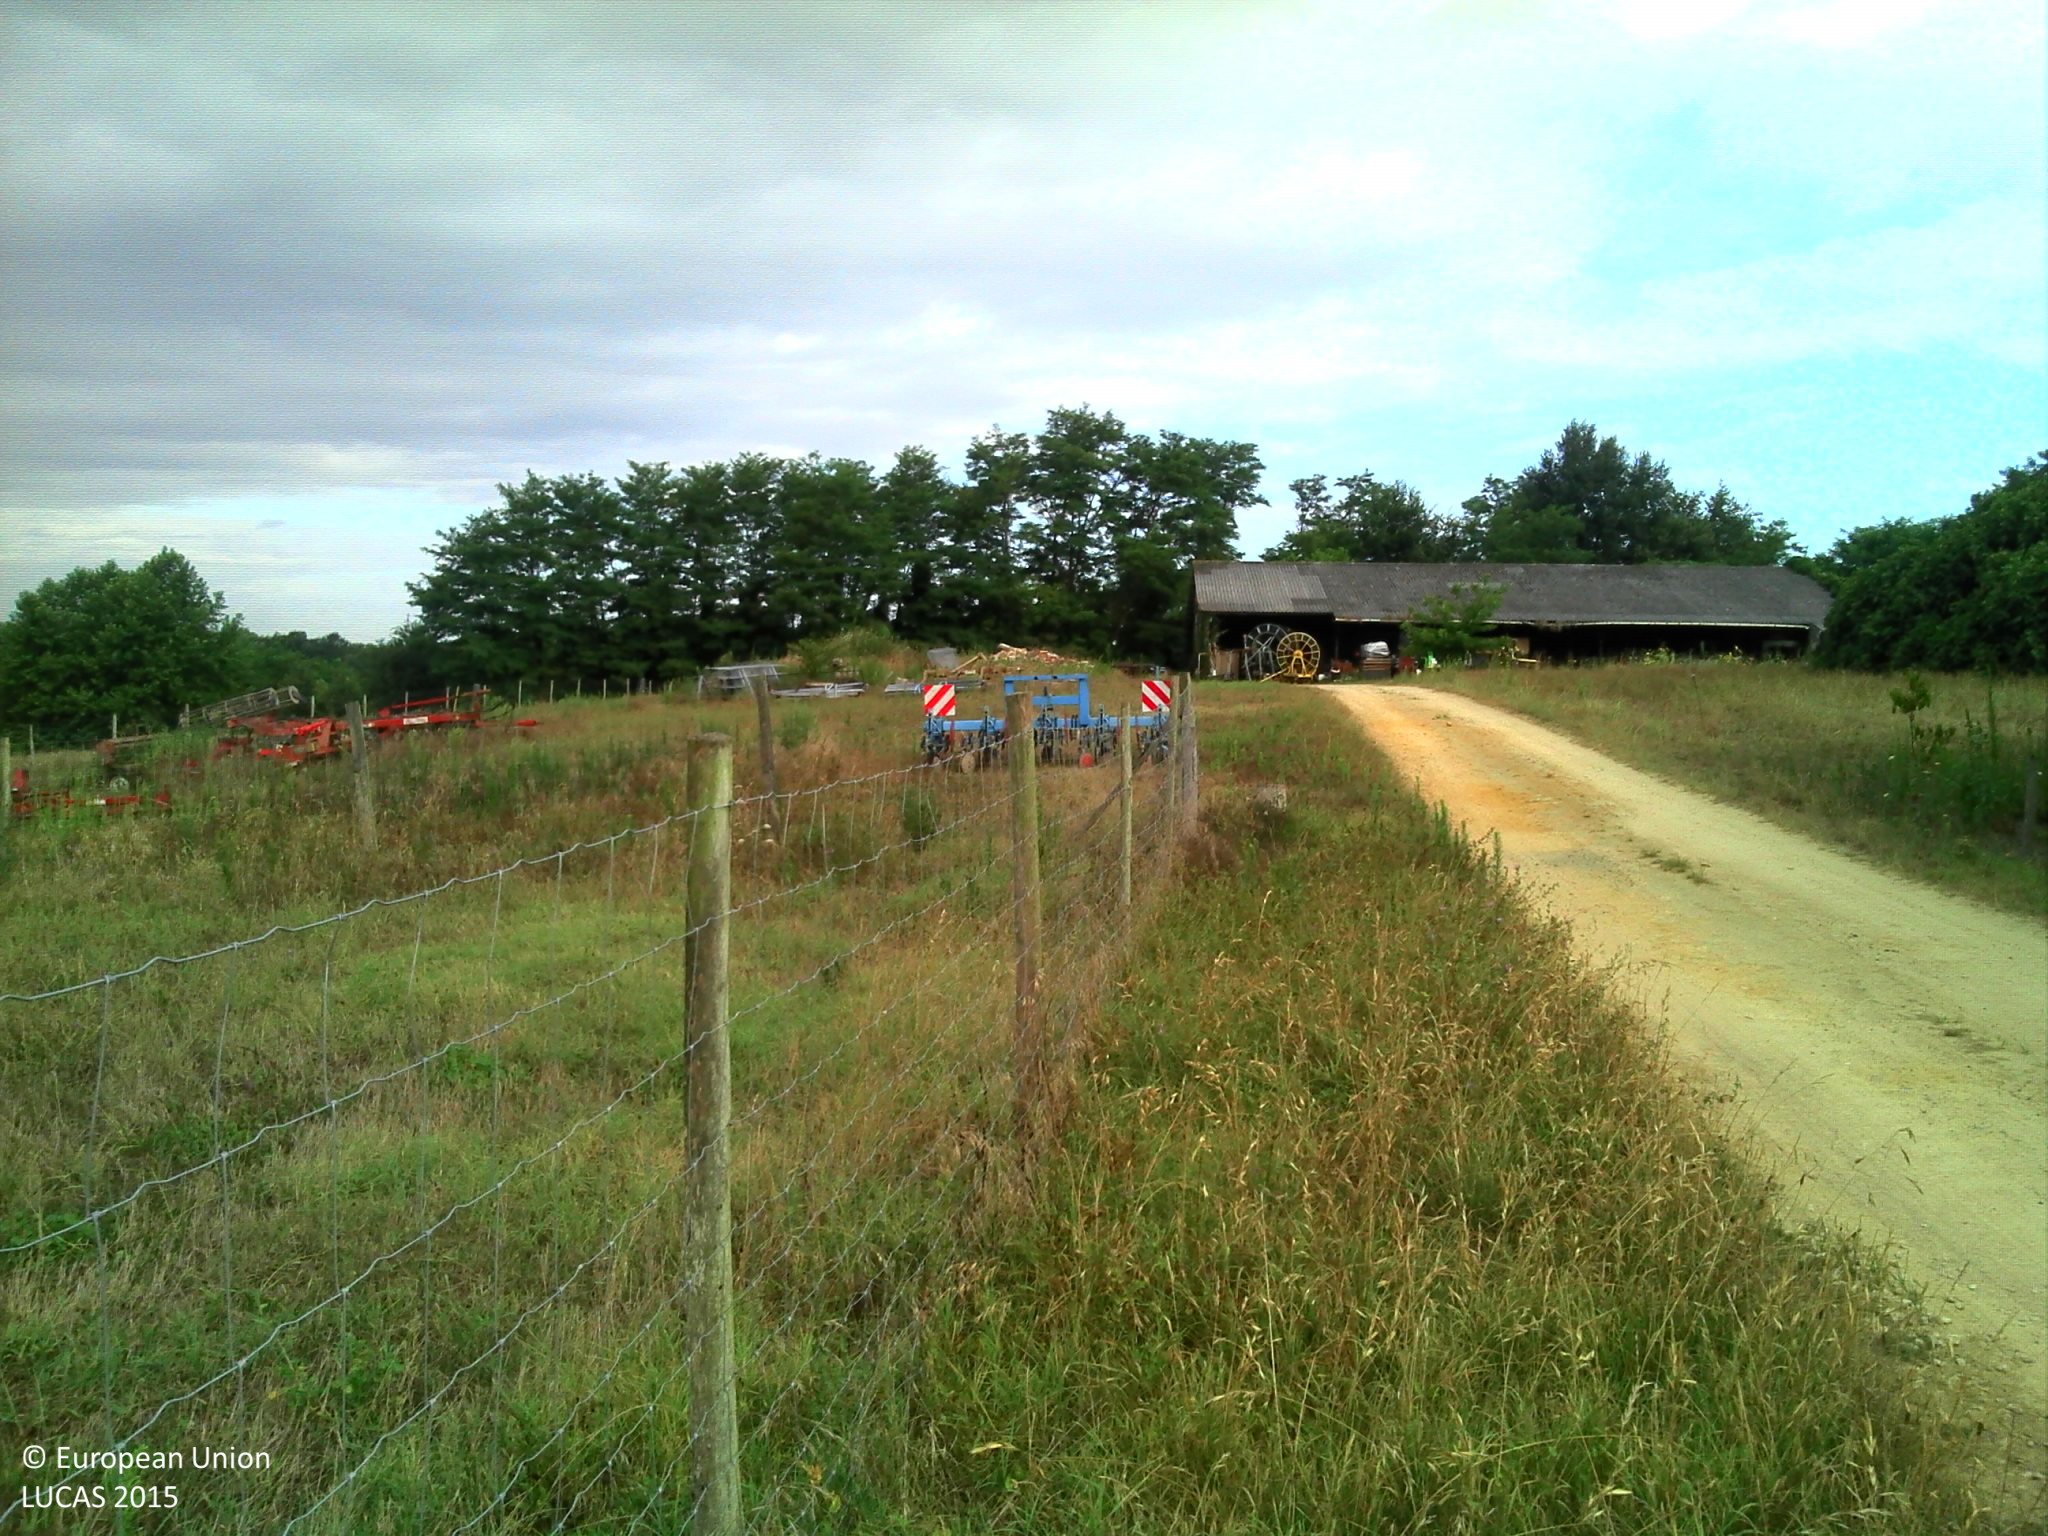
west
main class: Grassland
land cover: Grassland without tree/shrub cover
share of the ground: > 75 %
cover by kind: herbaceous plants 100 %
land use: Agriculture (excluding fallow land and kitchen gardens)
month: July
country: FR
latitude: 43.8196
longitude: -0.8187
